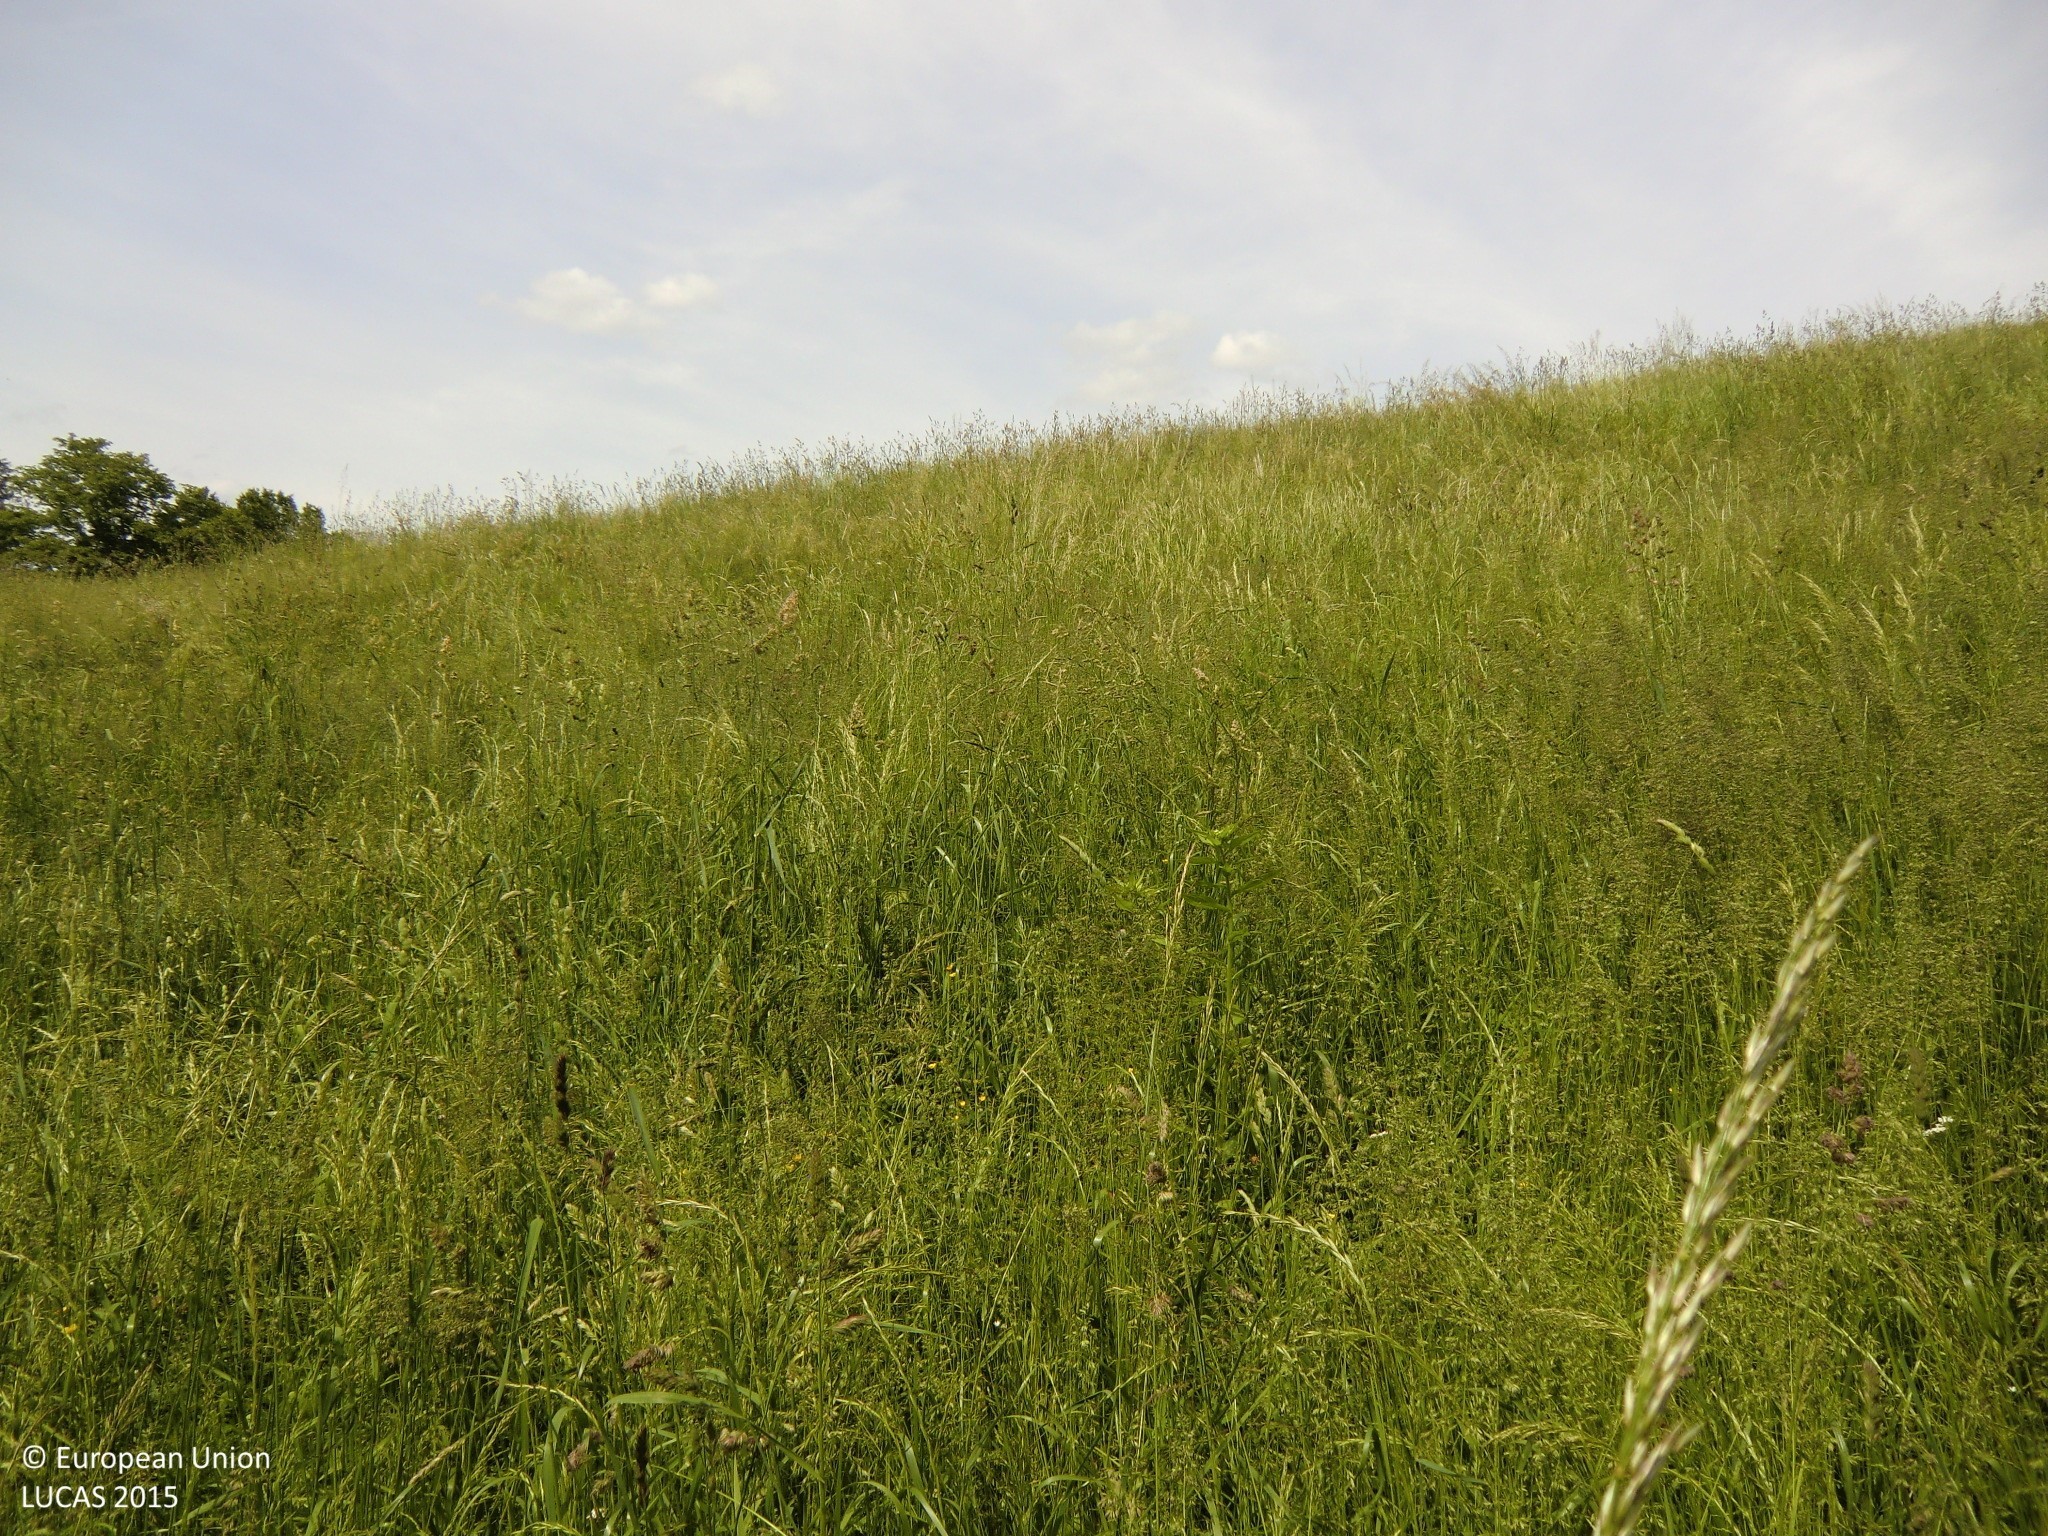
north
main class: Grassland
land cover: Grassland without tree/shrub cover
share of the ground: > 75 %
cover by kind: herbaceous plants 100 %
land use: Agriculture (excluding fallow land and kitchen gardens)
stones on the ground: < 10 %
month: May
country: AT
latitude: 48.2006
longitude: 14.9929
